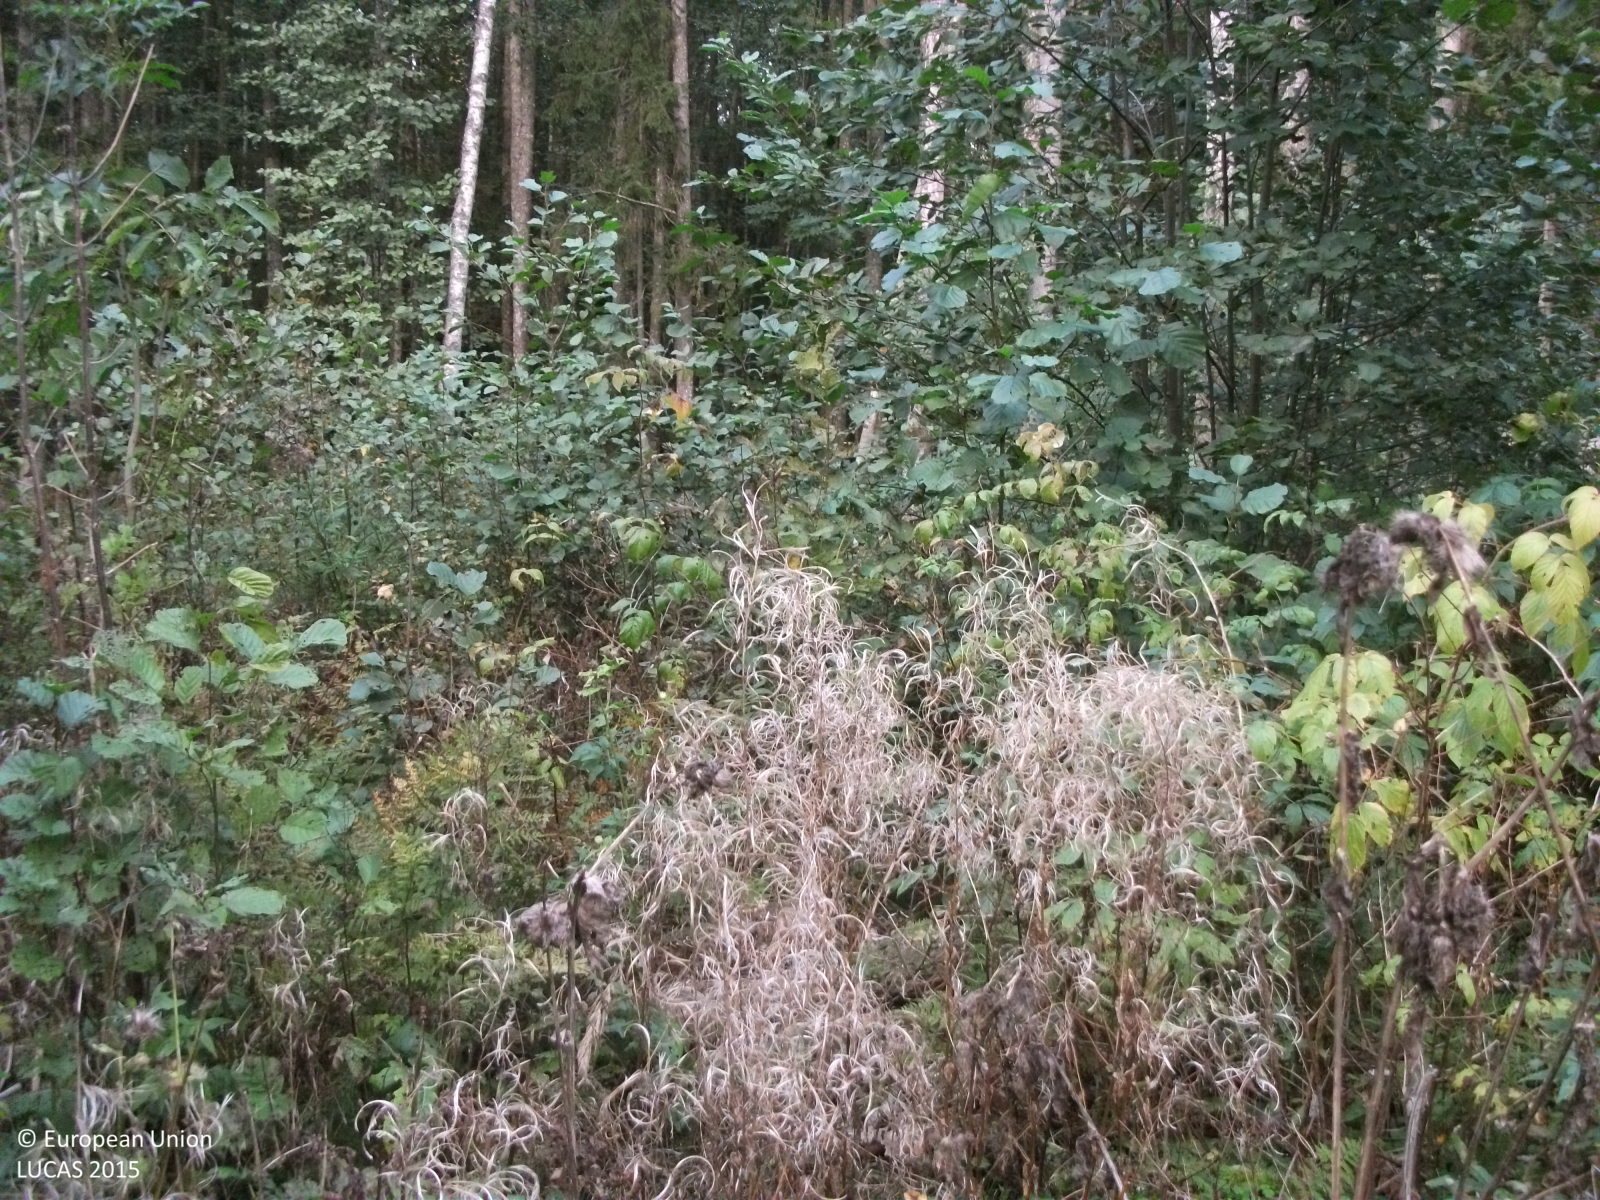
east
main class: Woodland
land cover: Broadleaved woodland
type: non-riverine alder, birch or aspen forest
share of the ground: 25 - 50 %
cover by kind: shrubs 50 %, broadleaved forest trees 40 %, herbaceous plants 10 %
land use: Forestry
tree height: < 5 m
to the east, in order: Broadleaved woodland; Other mixed woodland; Spruce dominated mixed woodland
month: September
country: LV
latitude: 57.8982
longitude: 24.5486
